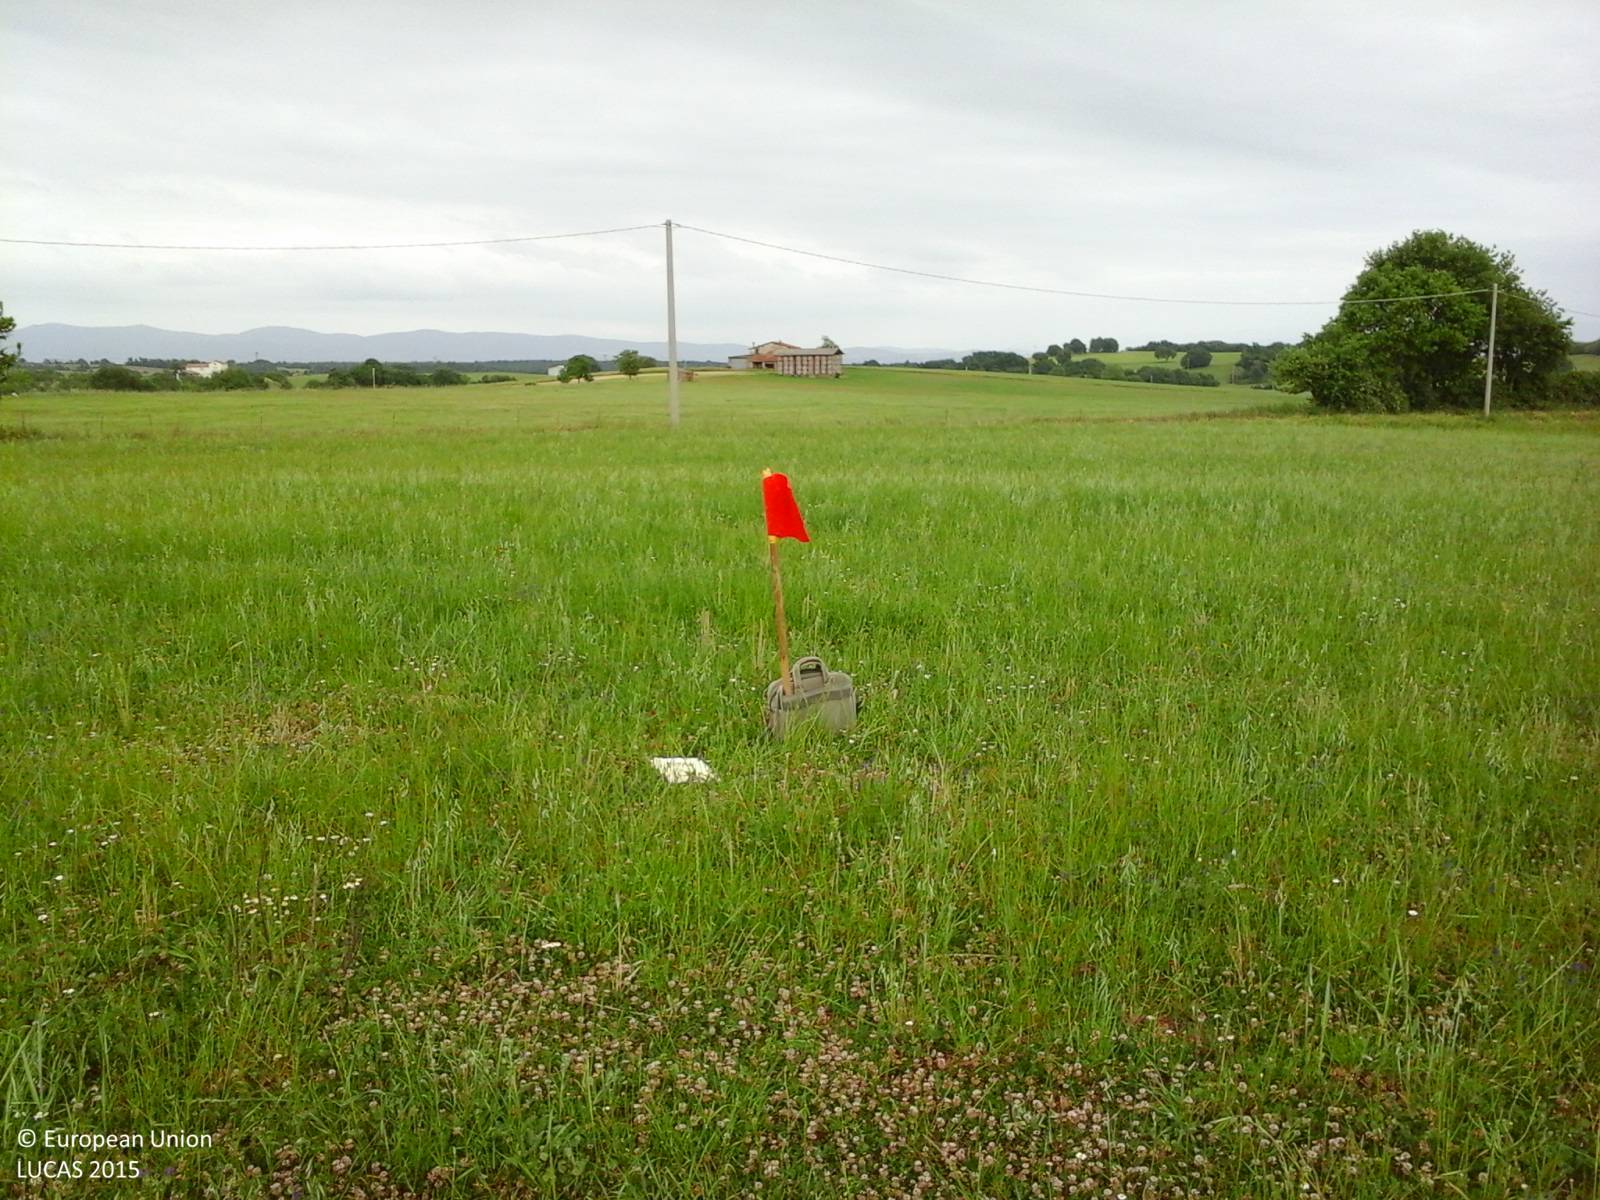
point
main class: Cropland
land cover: Other leguminous and mixtures for fodder
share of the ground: > 75 %
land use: Agriculture (excluding fallow land and kitchen gardens)
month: May
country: IT
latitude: 42.5239
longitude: 12.0989
